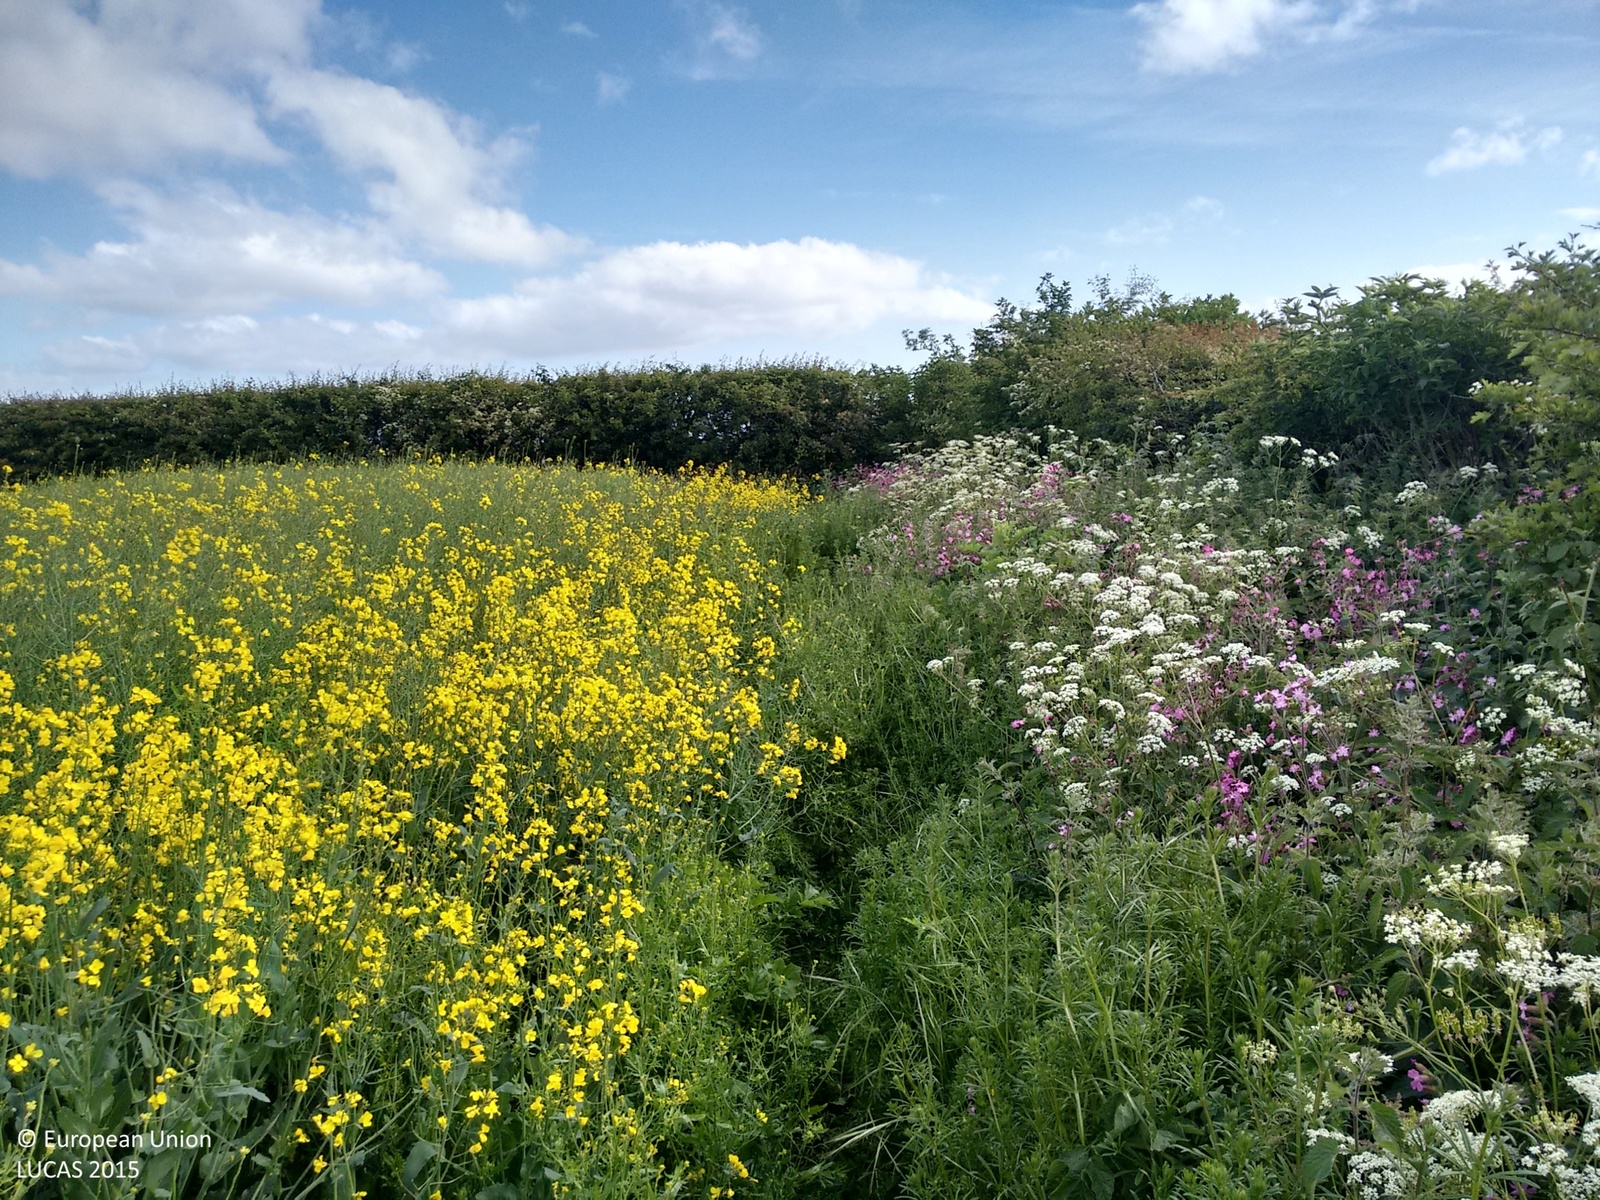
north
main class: Cropland
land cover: Rape and turnip rape
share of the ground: > 75 %
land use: Agriculture (excluding fallow land and kitchen gardens)
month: June
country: GB
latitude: 54.1903
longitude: -0.3487
